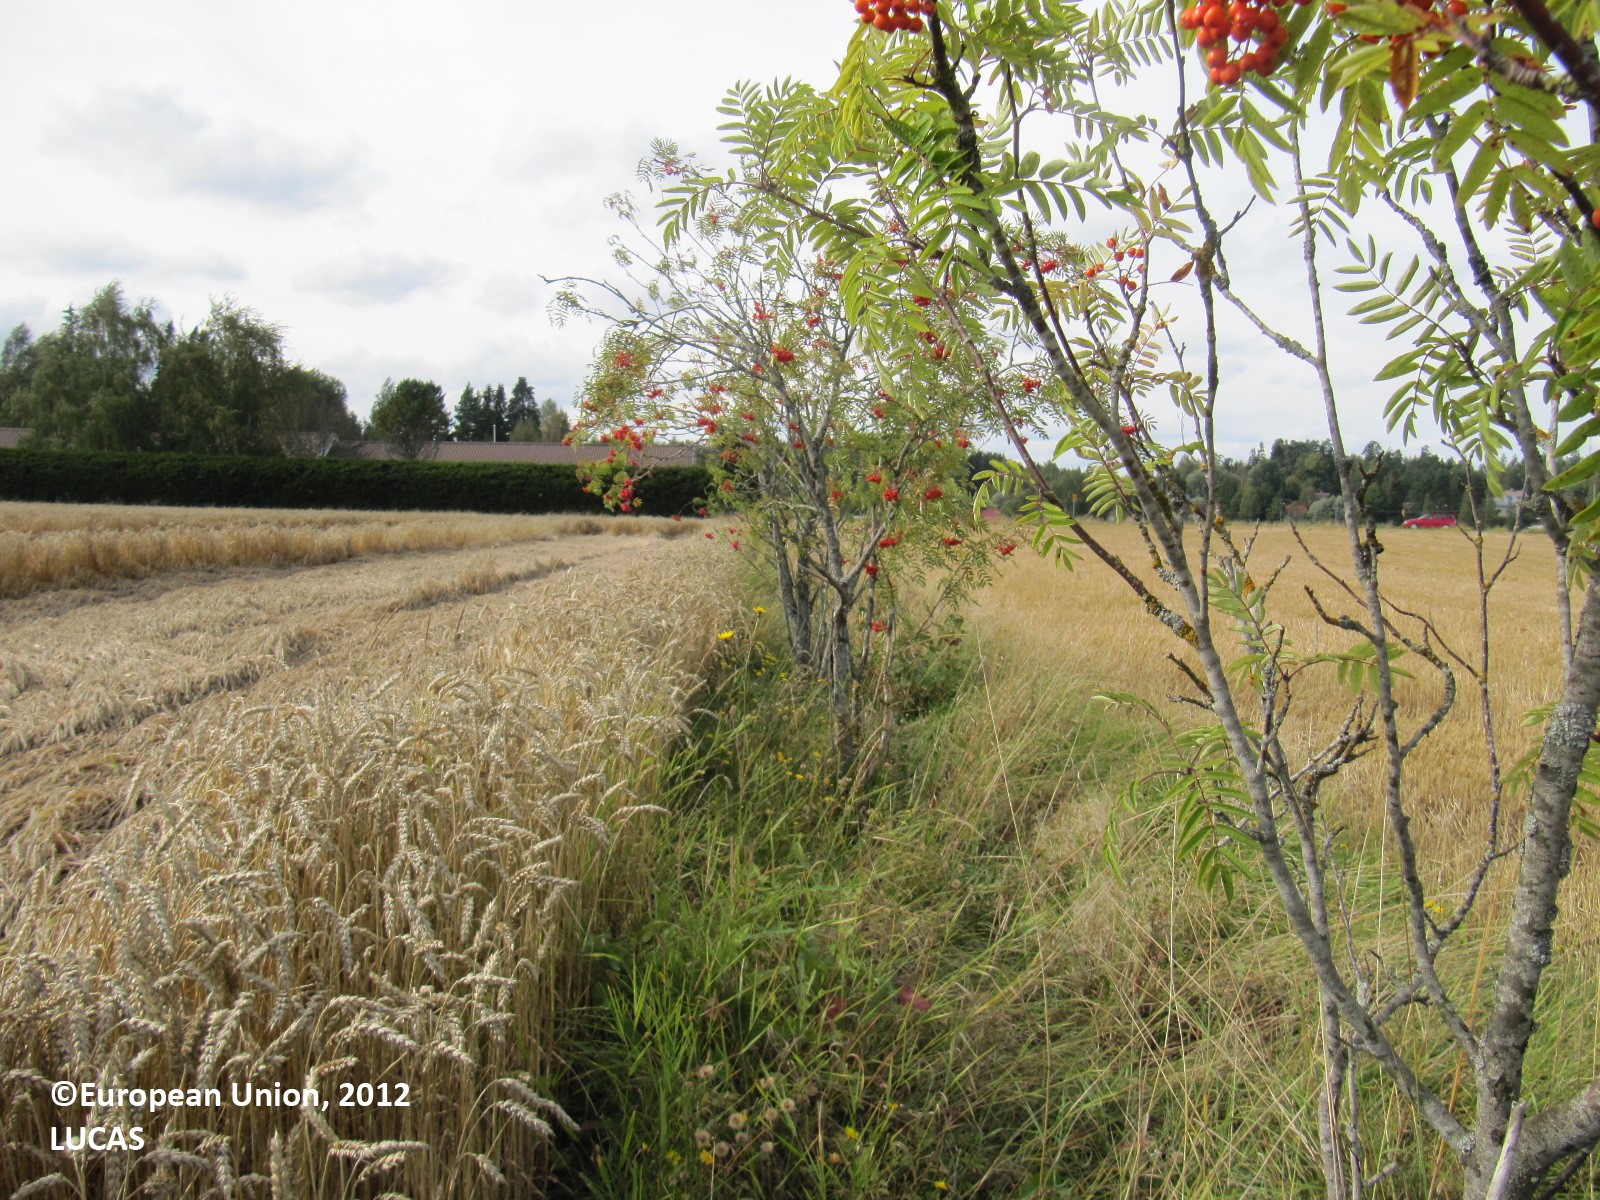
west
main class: Cropland
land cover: Common wheat
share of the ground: > 75 %
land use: Agriculture (excluding fallow land and kitchen gardens)
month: August
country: FI
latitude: 60.9590
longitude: 22.8706
